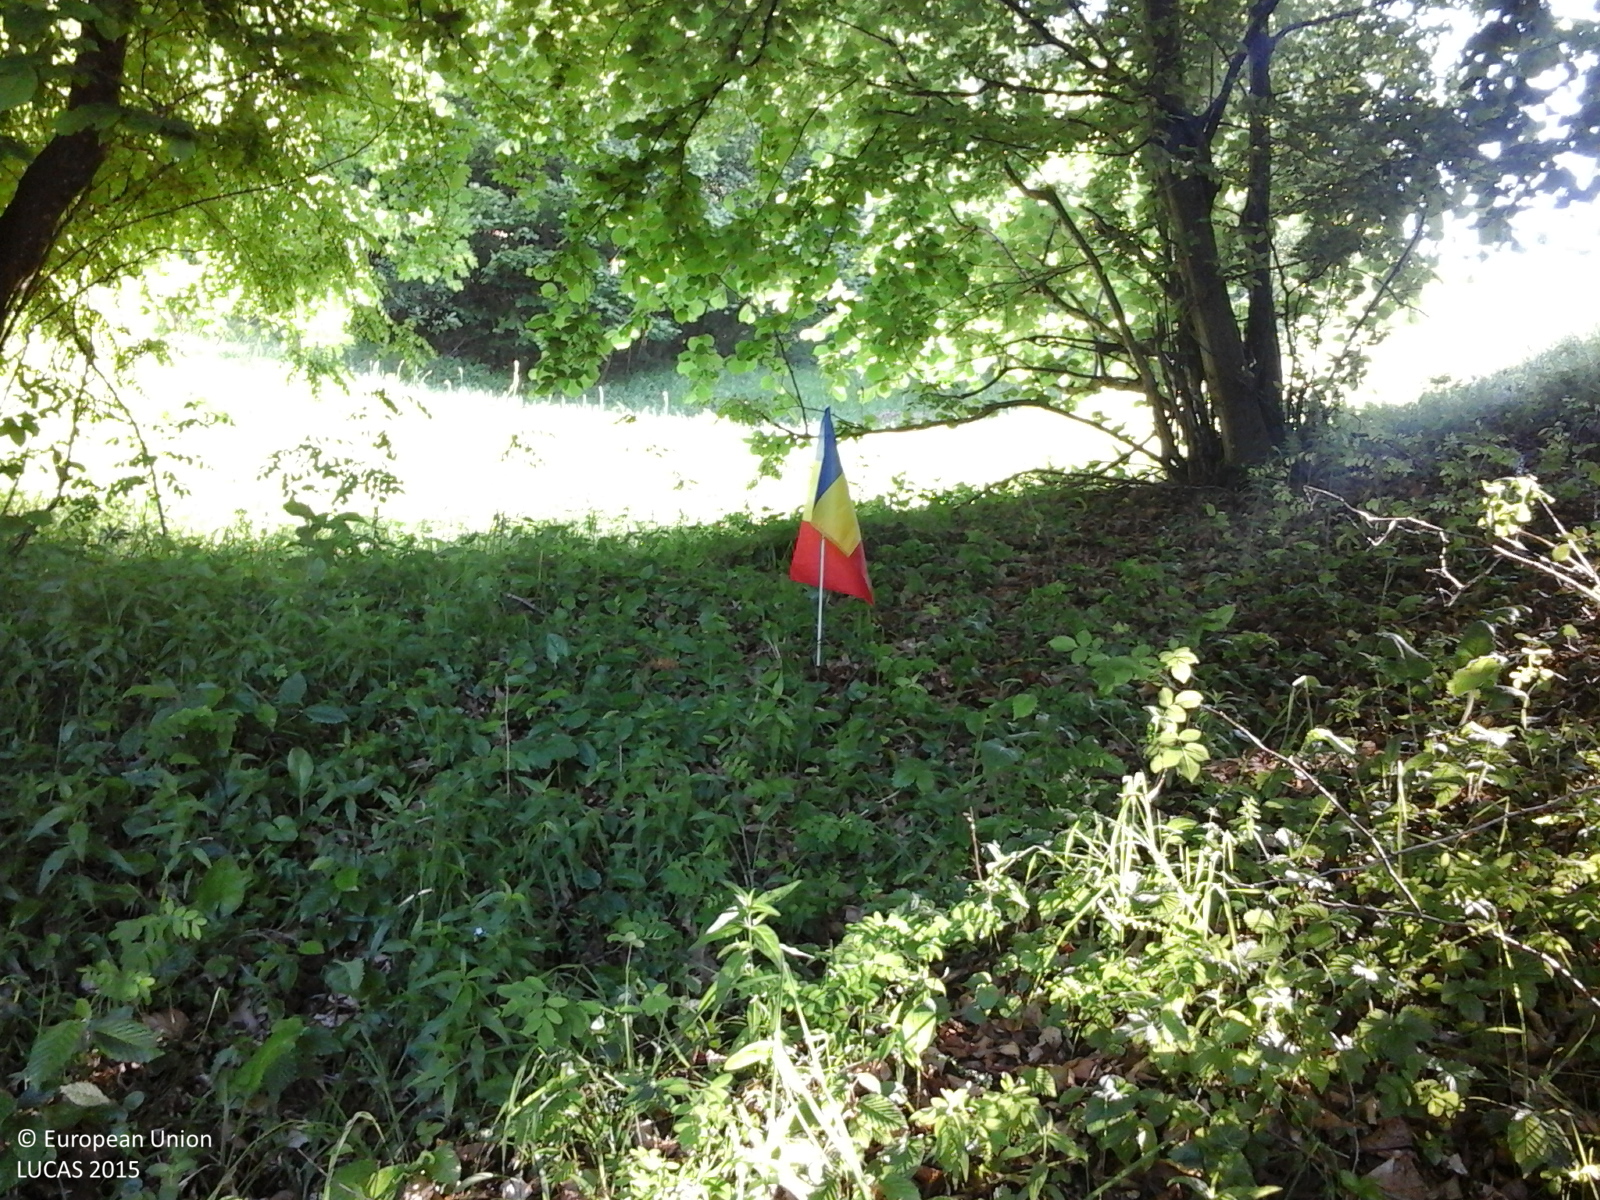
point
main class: Woodland
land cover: Broadleaved woodland
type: beech forest
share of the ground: > 75 %
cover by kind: broadleaved forest trees 100 %
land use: Forestry
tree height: > 5 m
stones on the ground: < 10 %
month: May
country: RO
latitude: 45.3079
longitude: 26.1992
